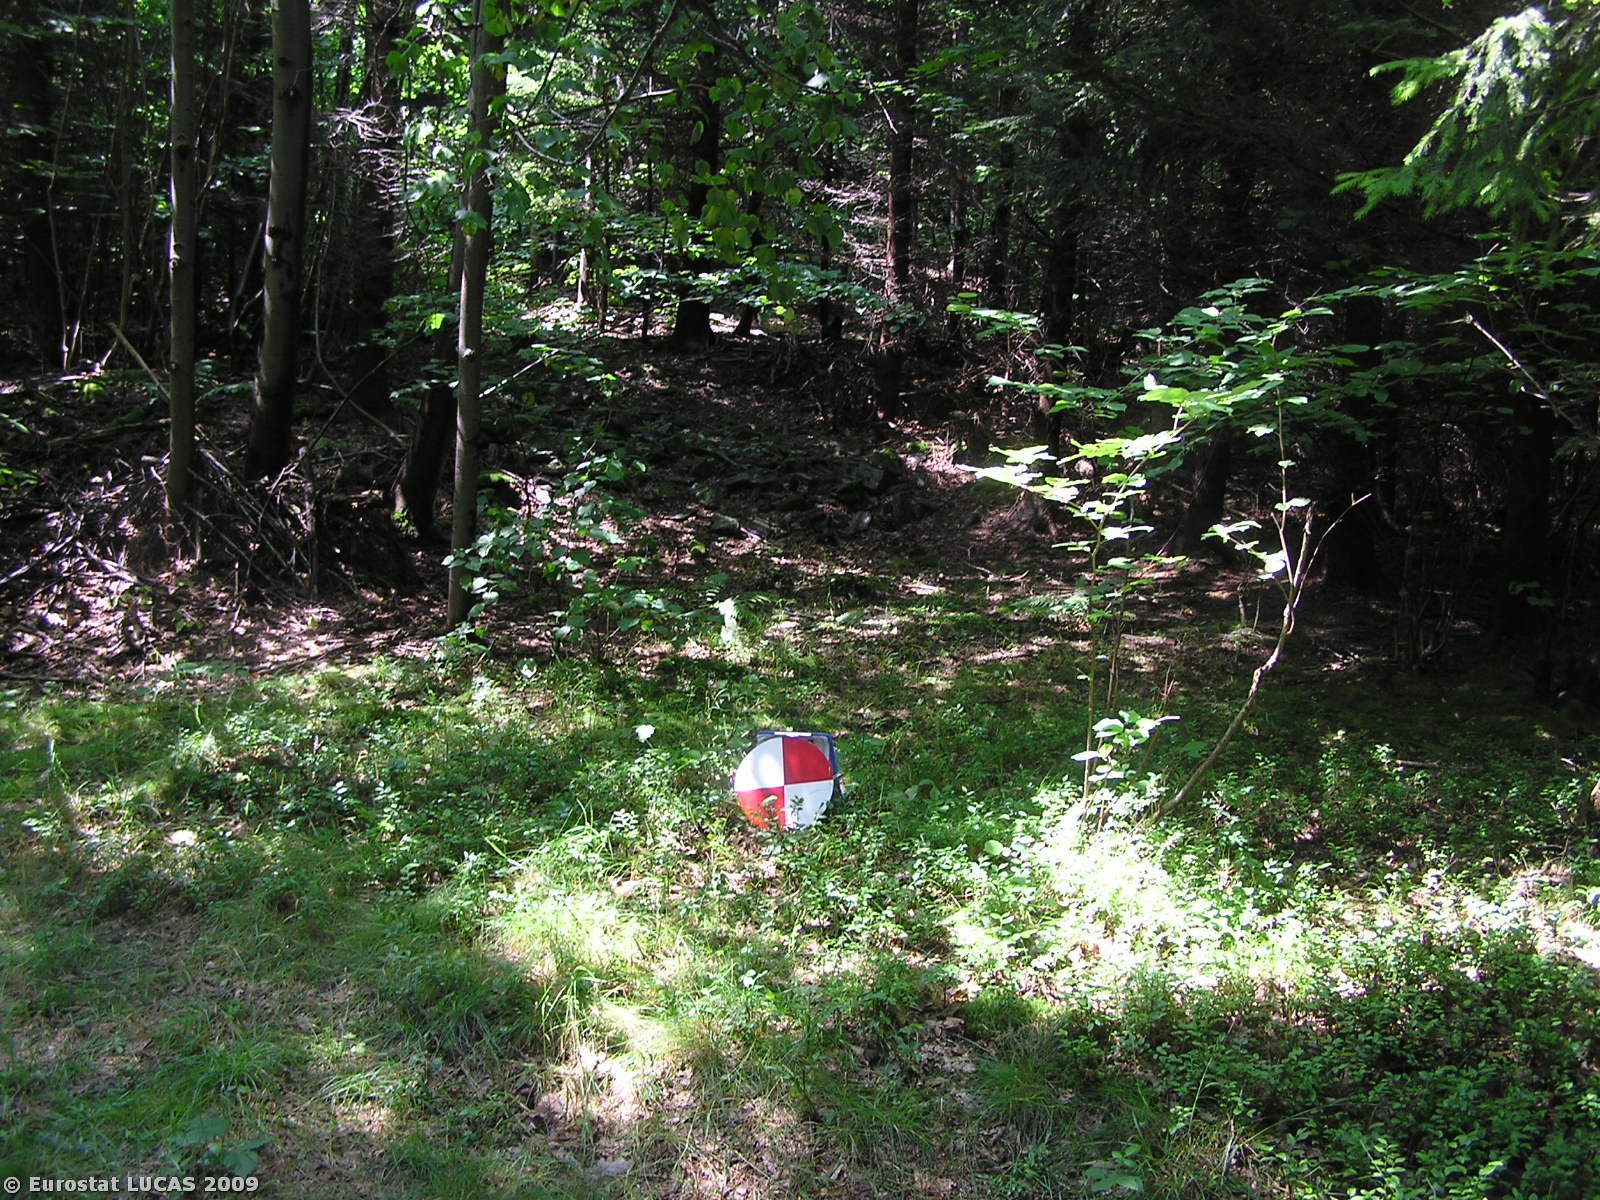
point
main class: Woodland
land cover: Mixed woodland
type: hemiboreal forest and nemoral coniferous forest and mixed broadleaved-coniferous forest
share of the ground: > 75 %
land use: Forestry
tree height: > 5 m
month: June
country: CZ
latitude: 50.2253
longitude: 17.5116
